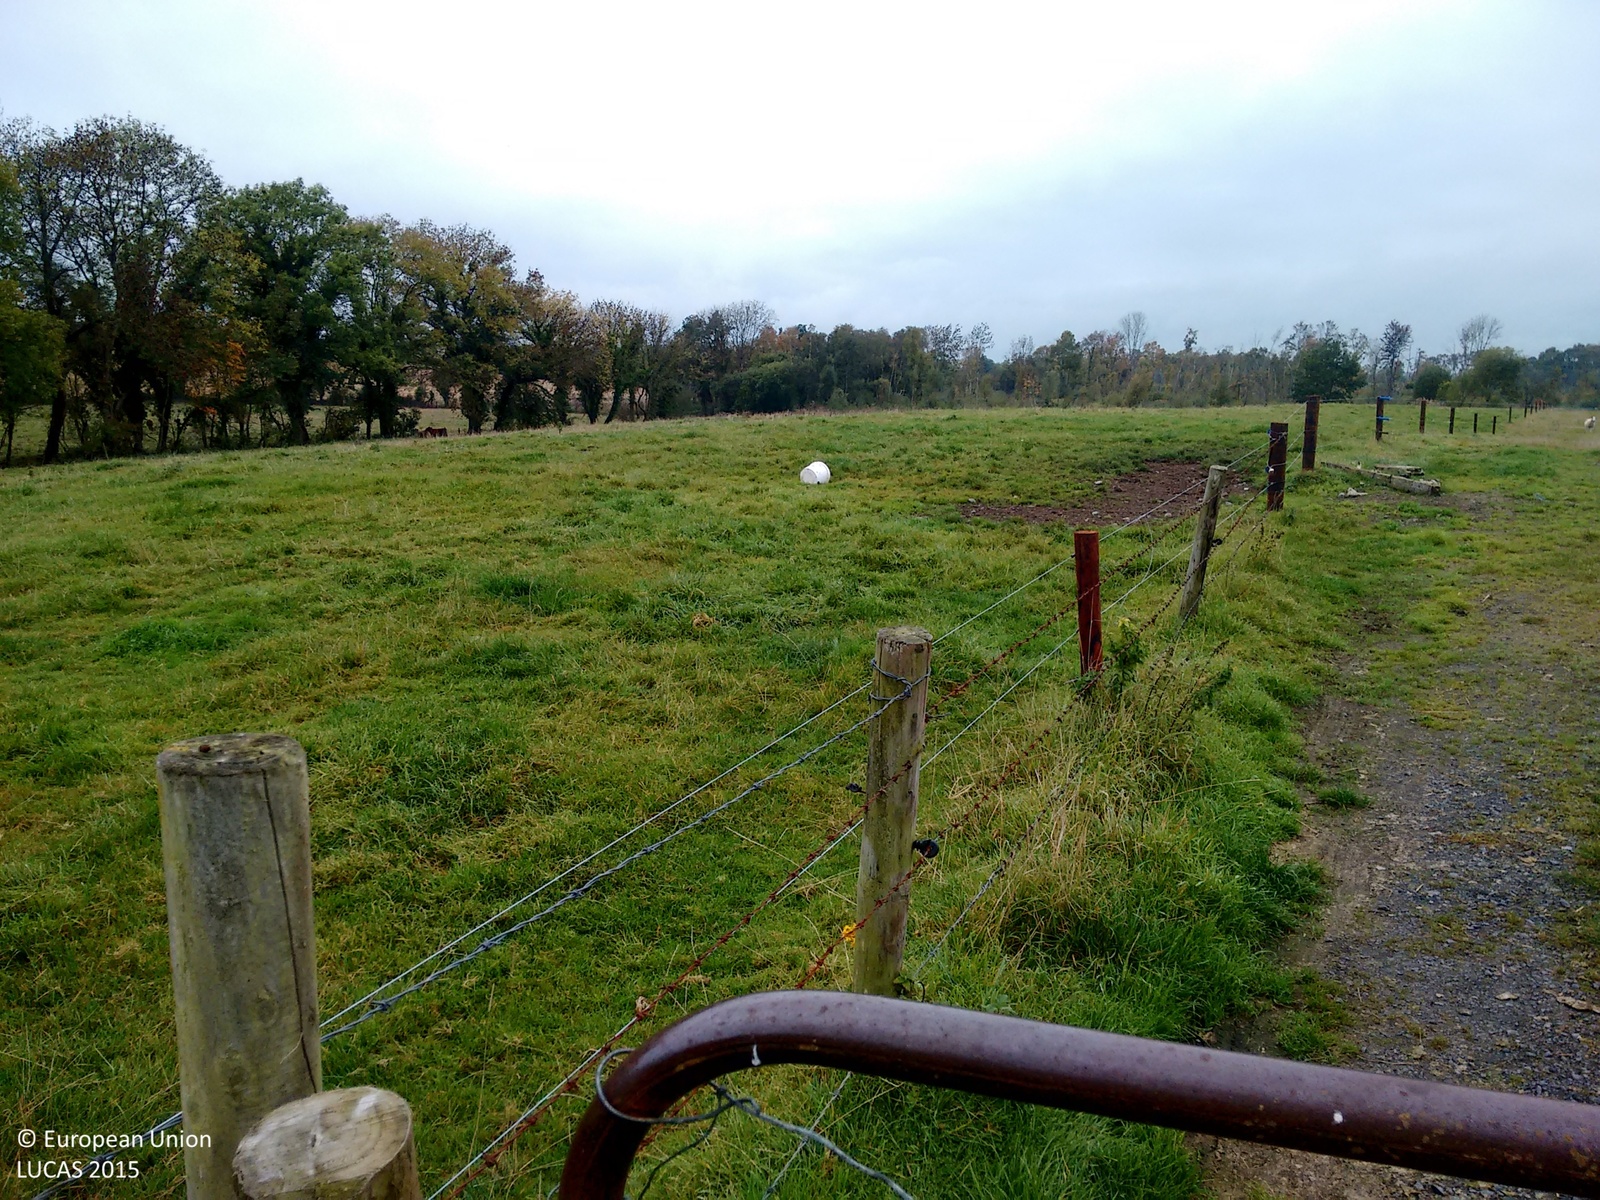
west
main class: Grassland
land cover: Grassland without tree/shrub cover
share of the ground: > 75 %
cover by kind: herbaceous plants 100 %
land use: Agriculture (excluding fallow land and kitchen gardens)
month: October
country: IE
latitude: 52.9946
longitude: -7.8863
